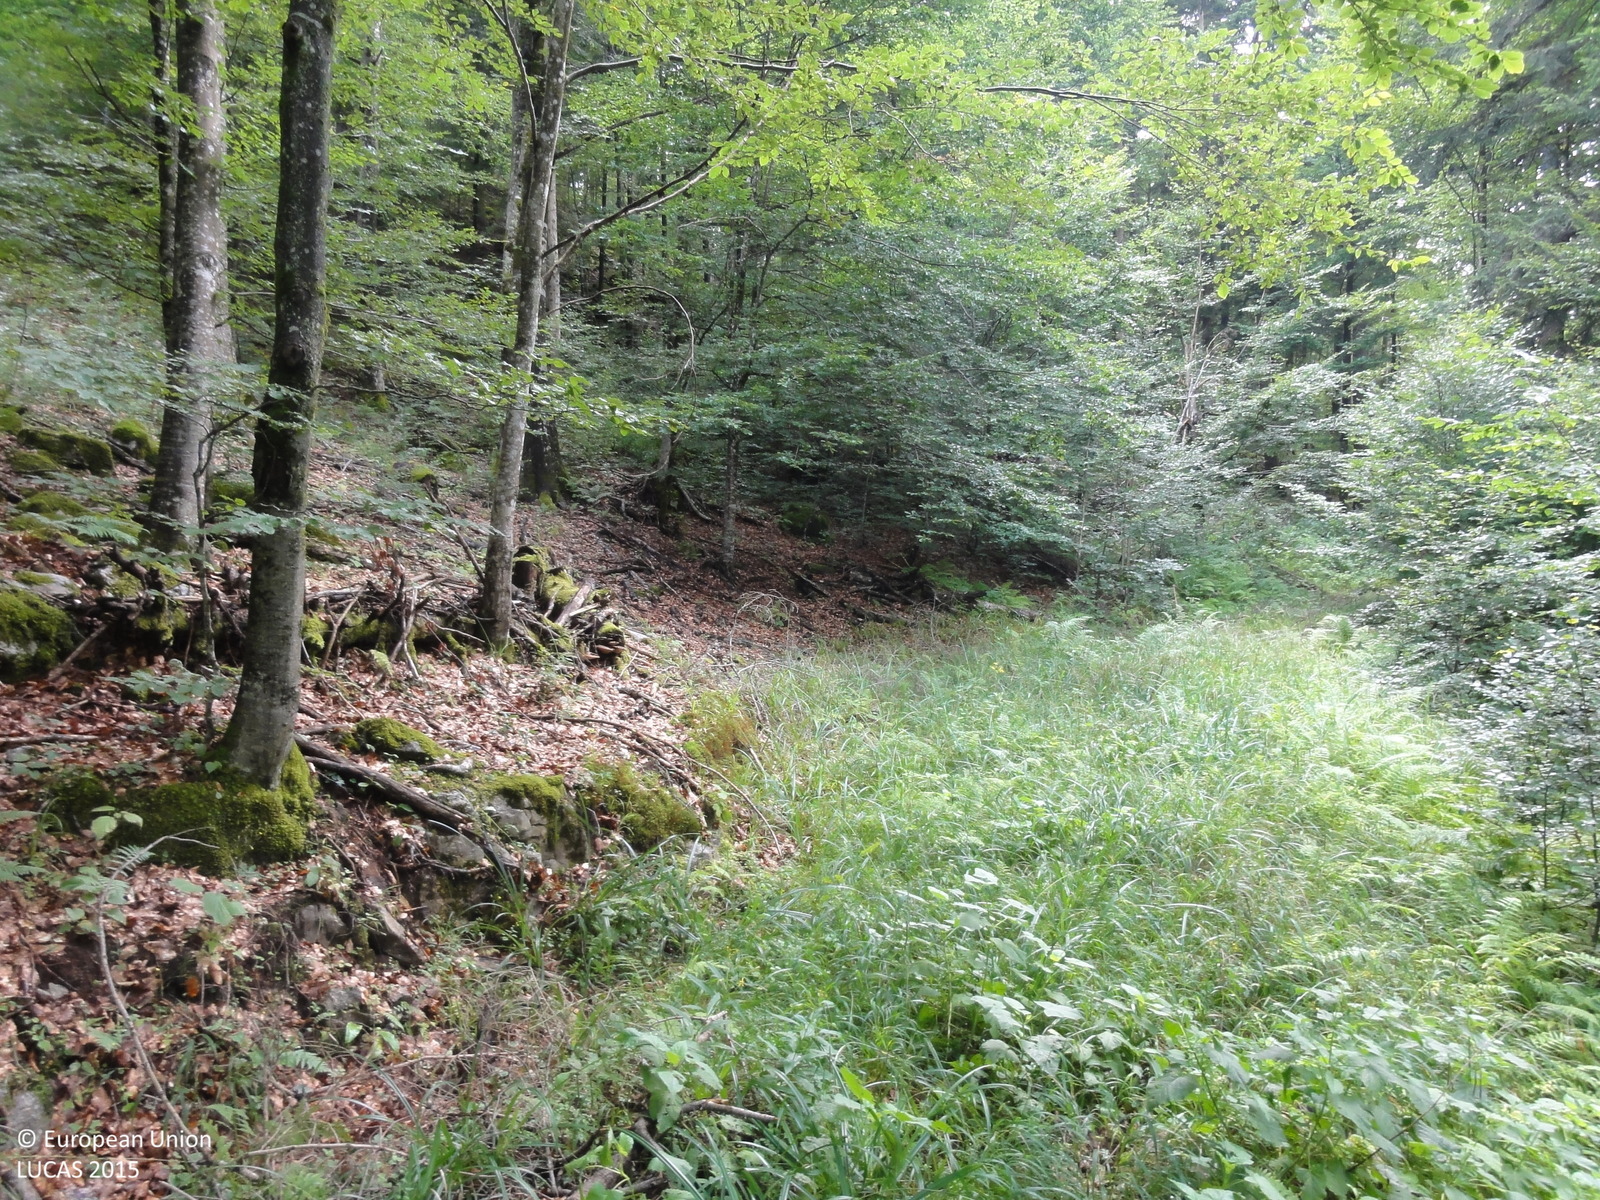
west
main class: Woodland
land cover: Spruce dominated mixed woodland
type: mountainous beech forest
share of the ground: > 75 %
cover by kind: broadleaved forest trees 60 %, coniferous forest trees 25 %, herbaceous plants 10 %, shrubs 5 %
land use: Forestry
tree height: > 5 m
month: July
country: SI
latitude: 45.6296
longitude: 14.8060
